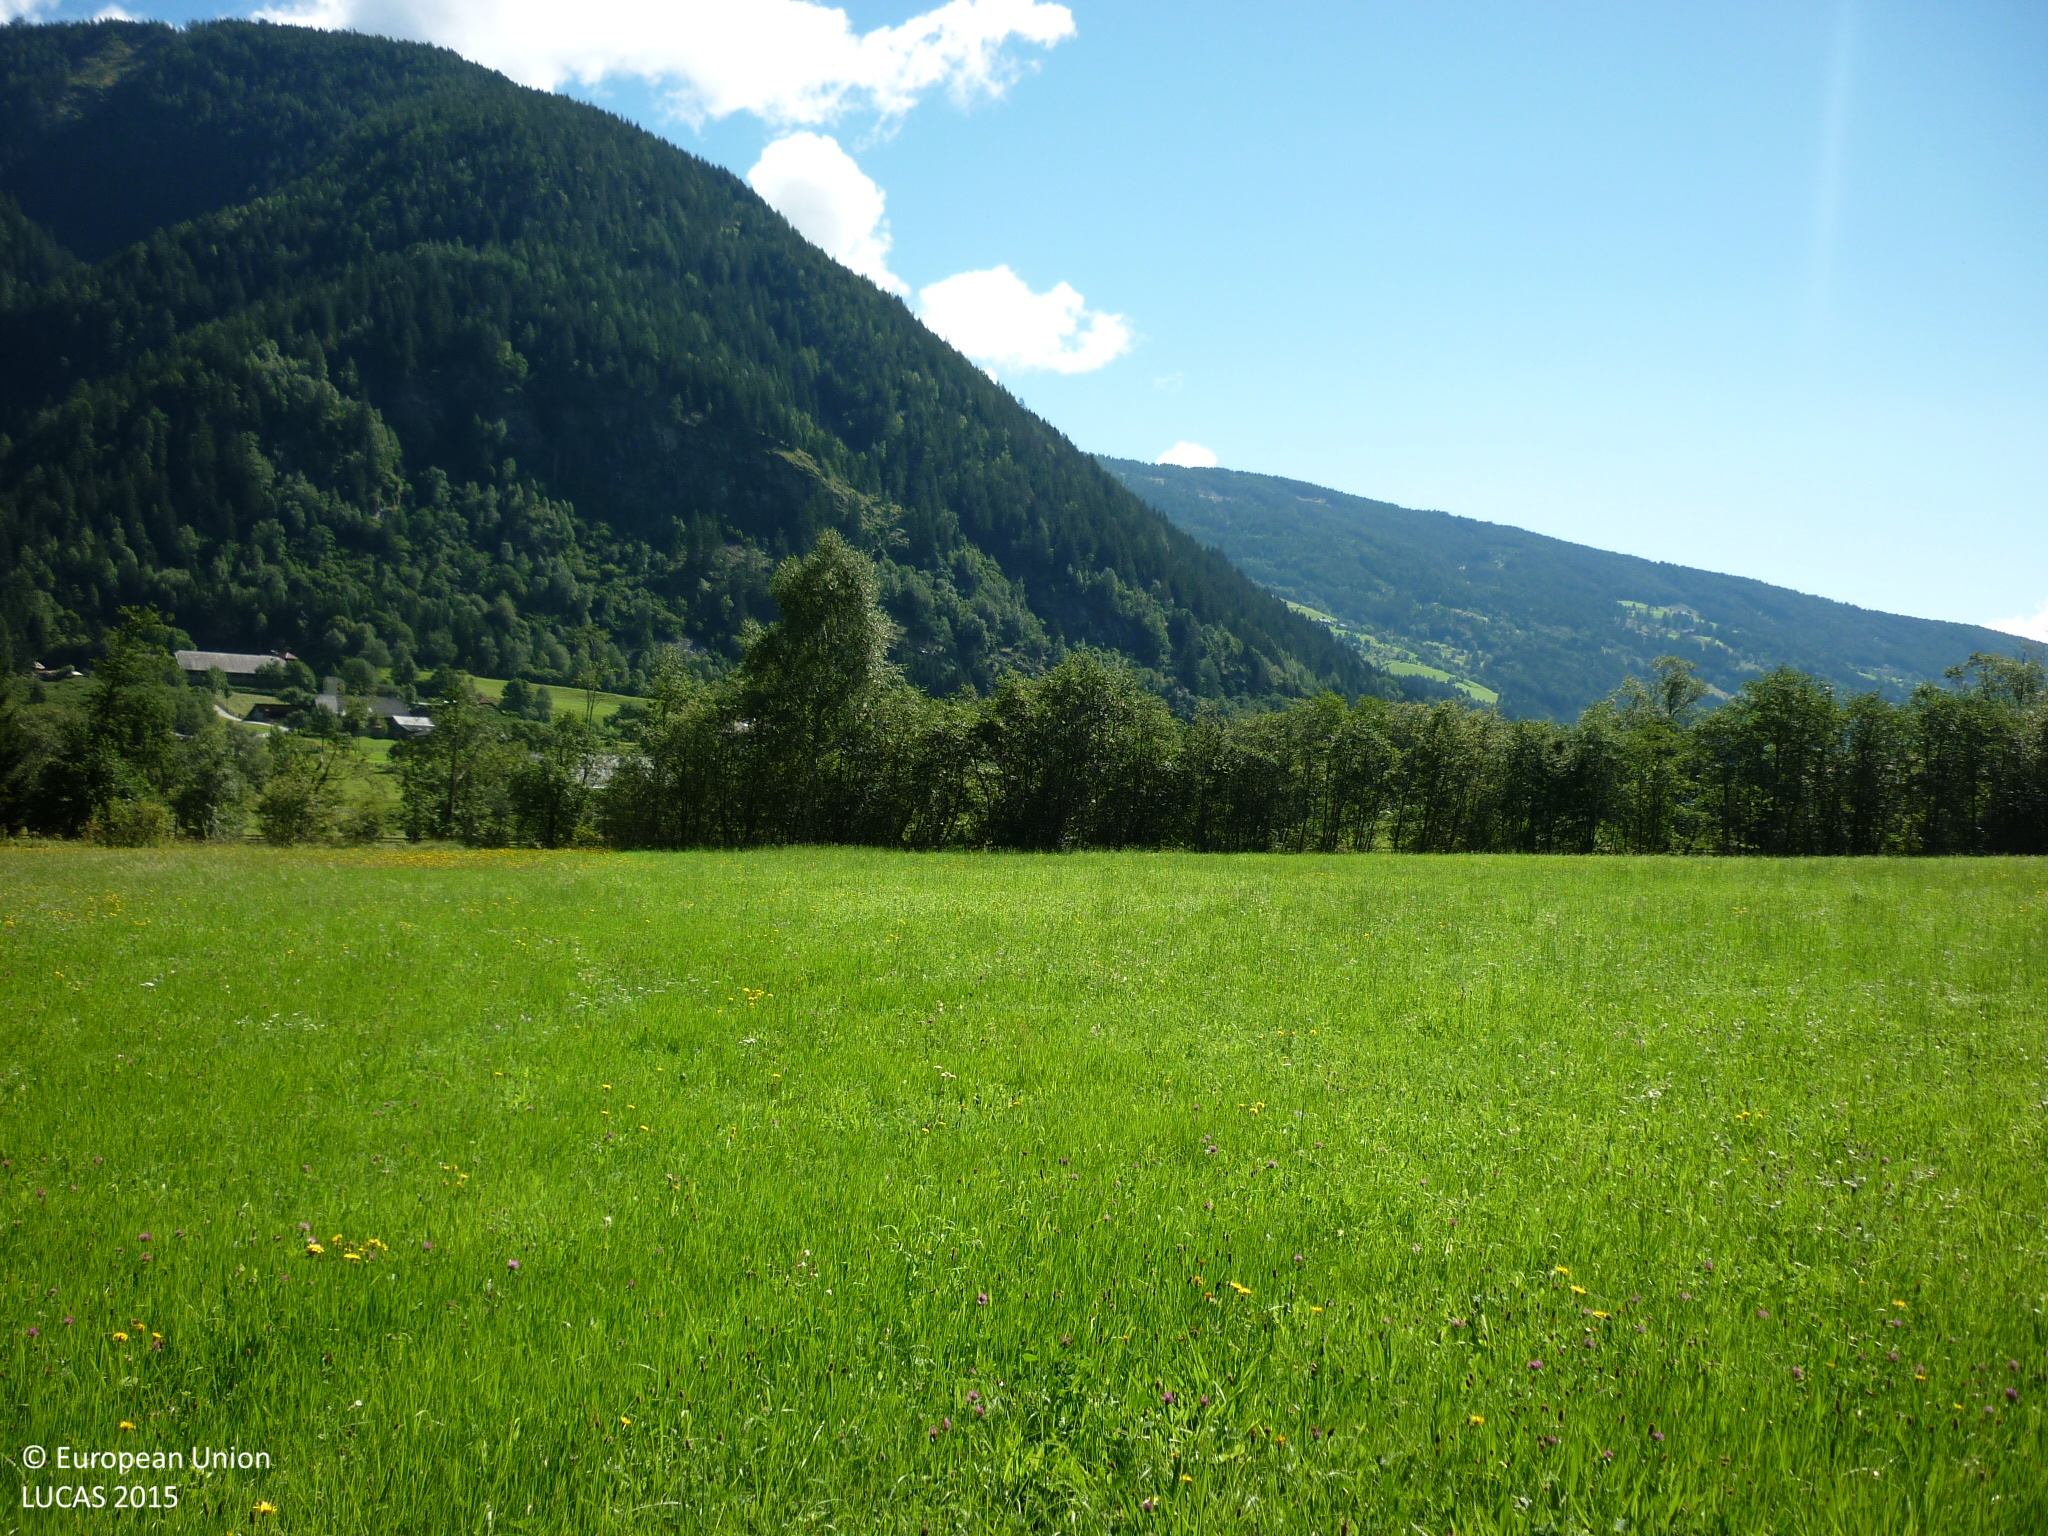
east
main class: Grassland
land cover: Grassland without tree/shrub cover
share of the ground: > 75 %
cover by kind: herbaceous plants 100 %
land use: Agriculture (excluding fallow land and kitchen gardens)
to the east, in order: Grassland without tree/shrub cover; Abandoned hedges; Inland fresh running water; Abandoned hedges; Grass margins; Paved roads, cycling and walking lanes; Grass margins; Fences; Grassland without tree/shrub cover; Fences; Grassland without tree/shrub cover
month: August
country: AT
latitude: 46.9615
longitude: 13.4802
